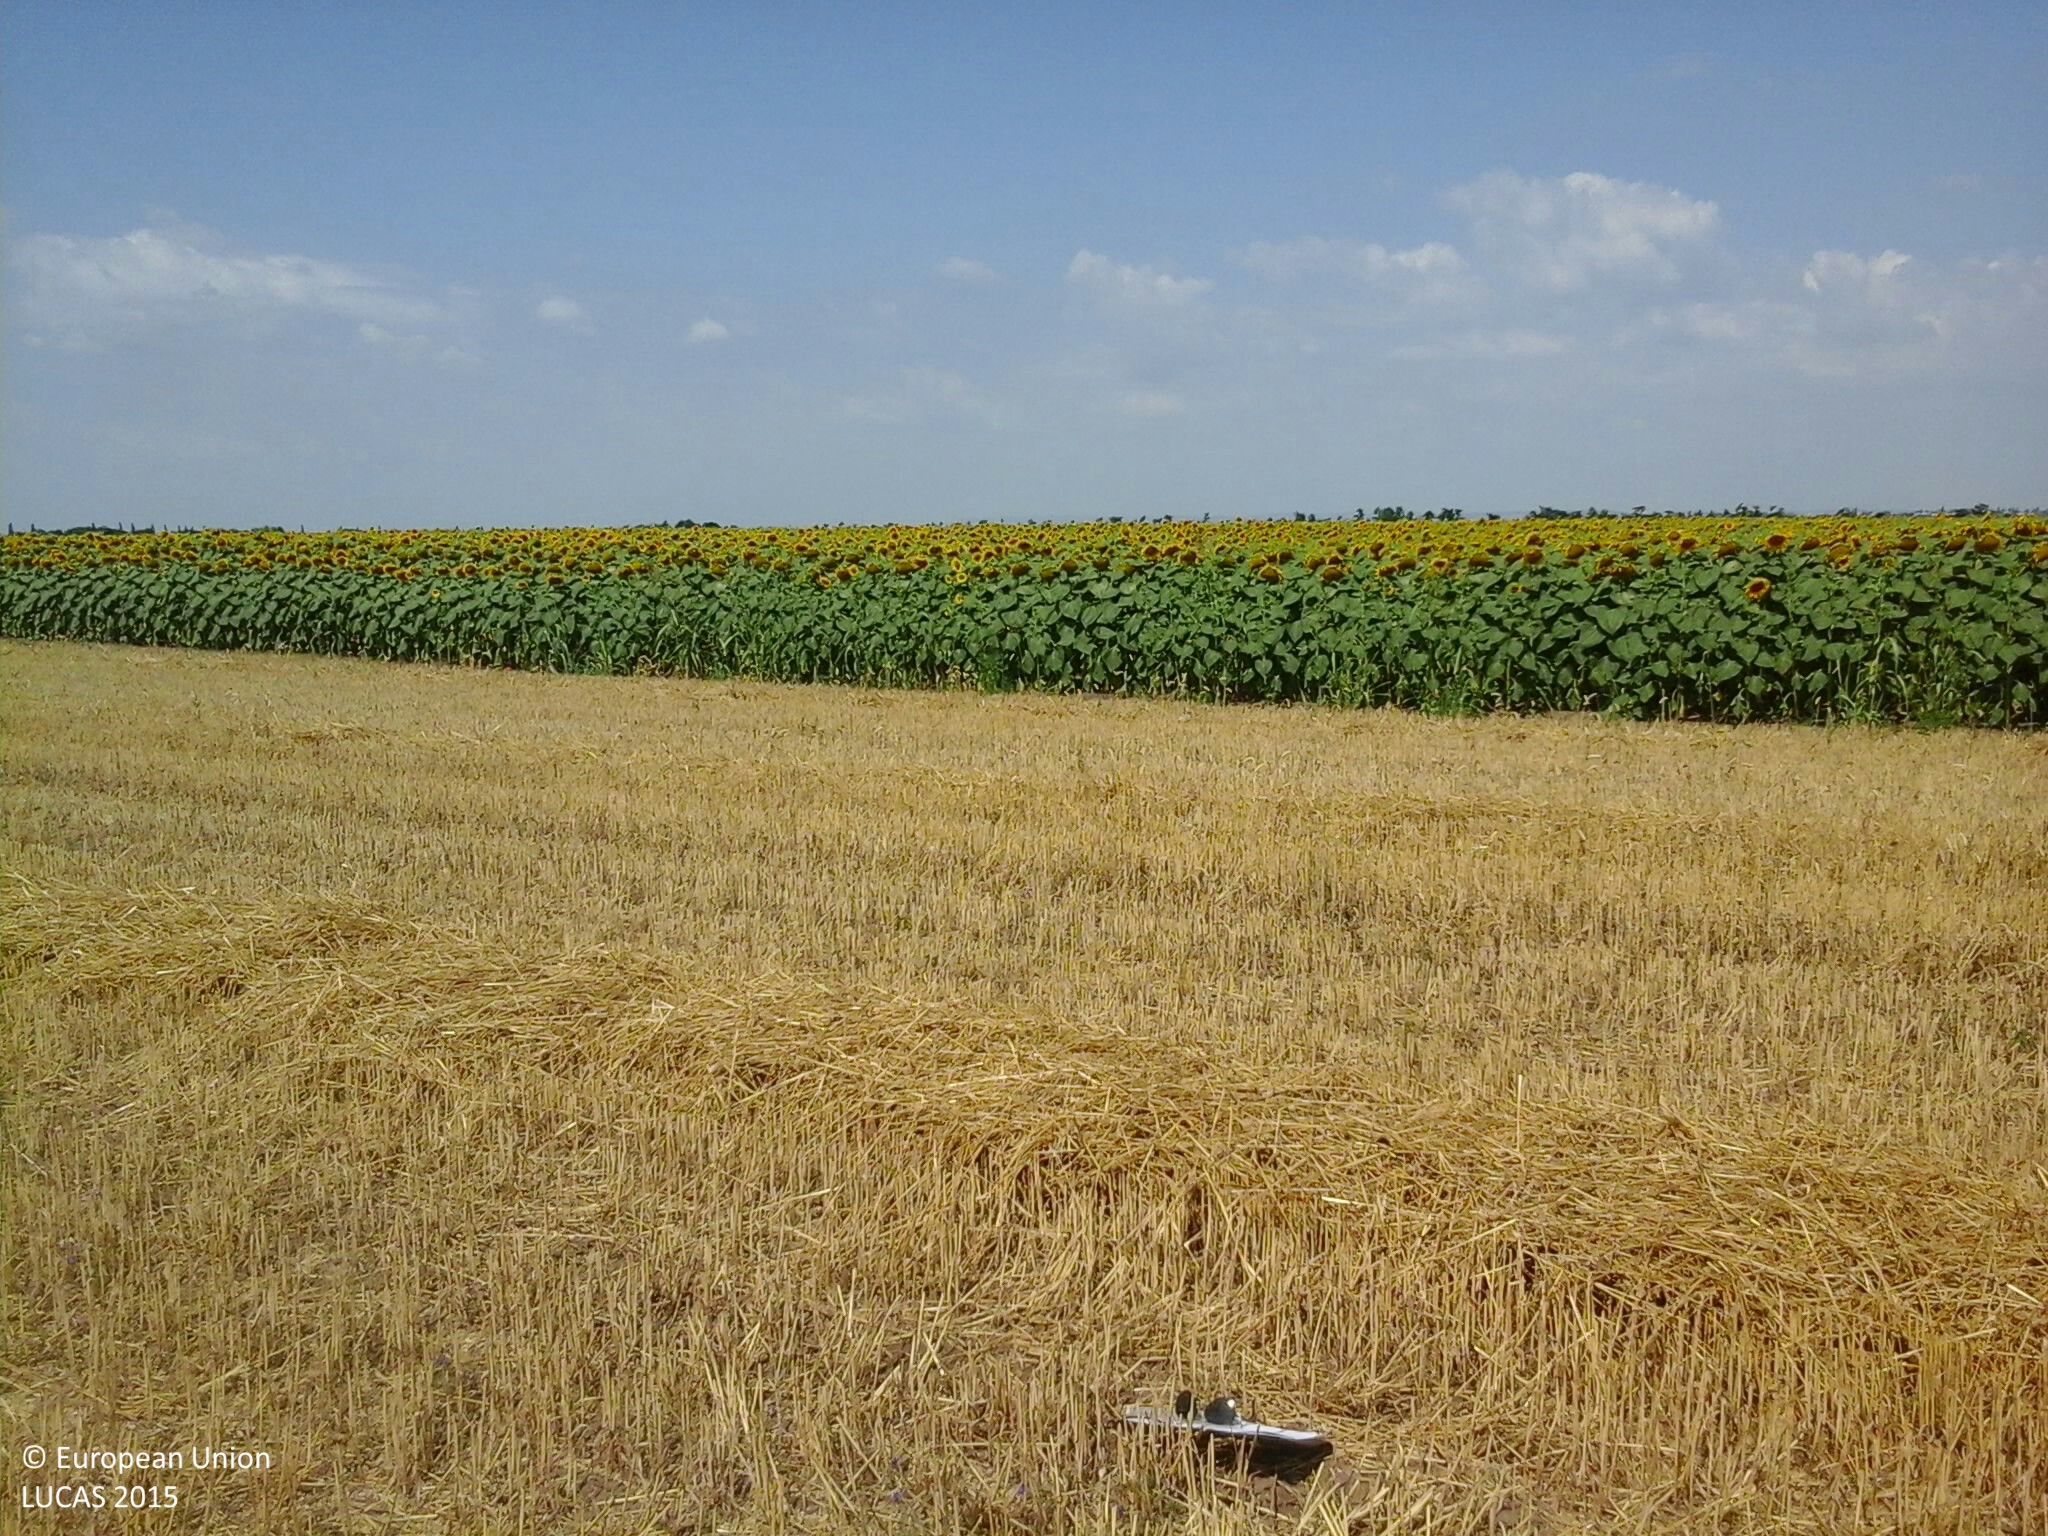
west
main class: Cropland
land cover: Rye
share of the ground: 50 - 75 %
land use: Agriculture (excluding fallow land and kitchen gardens)
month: July
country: HU
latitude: 47.1514
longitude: 18.5193
